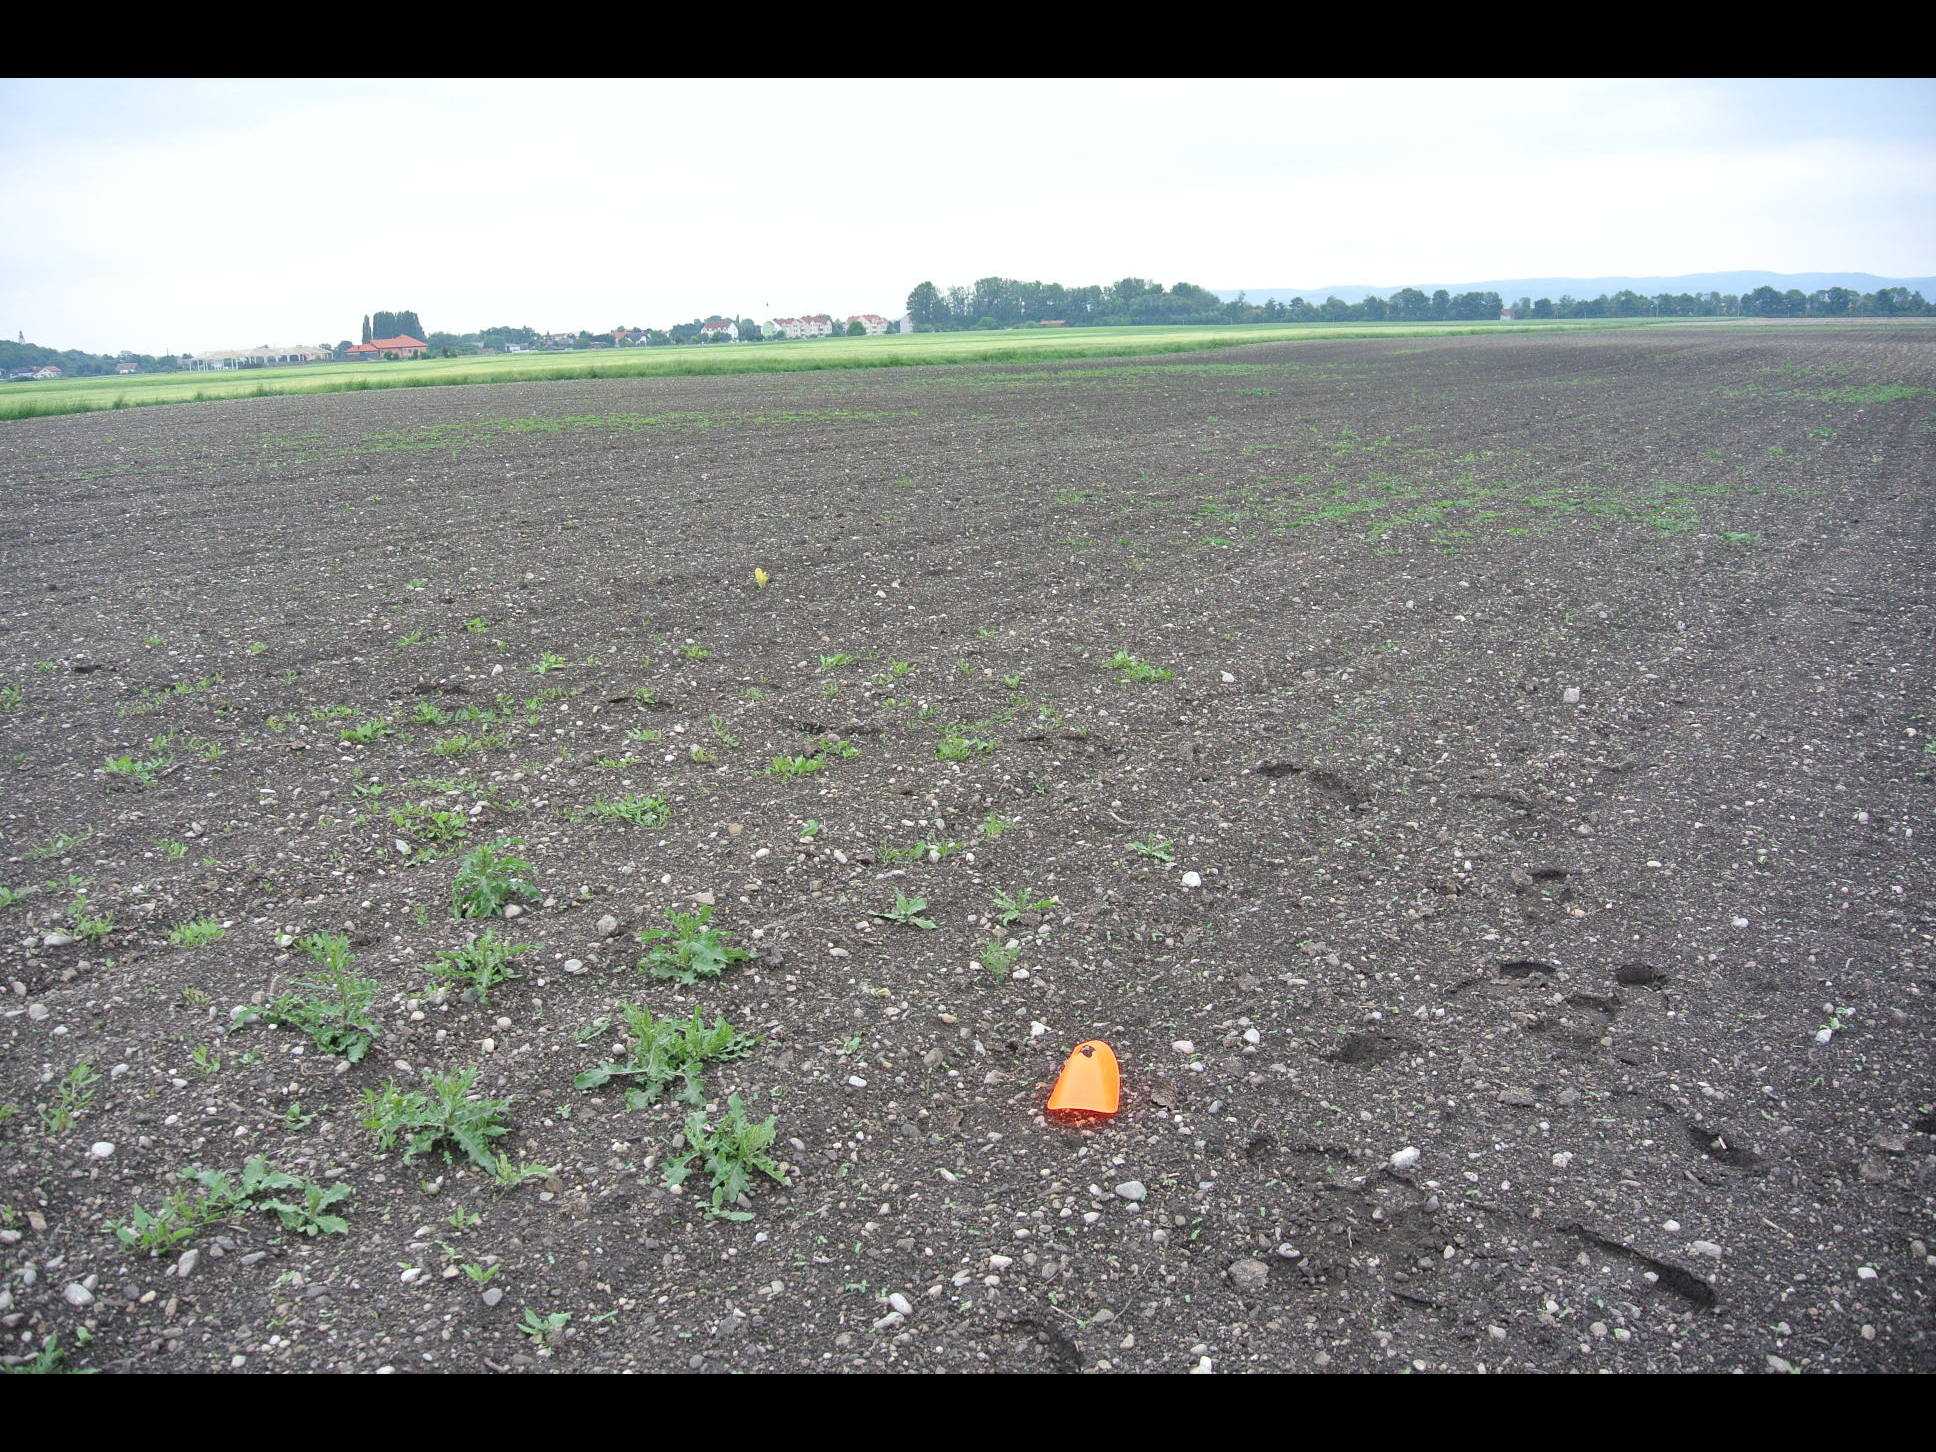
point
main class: Cropland
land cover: Sunflower
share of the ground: > 75 %
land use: Agriculture (excluding fallow land and kitchen gardens)
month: May
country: AT
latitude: 47.9953
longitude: 16.5047
